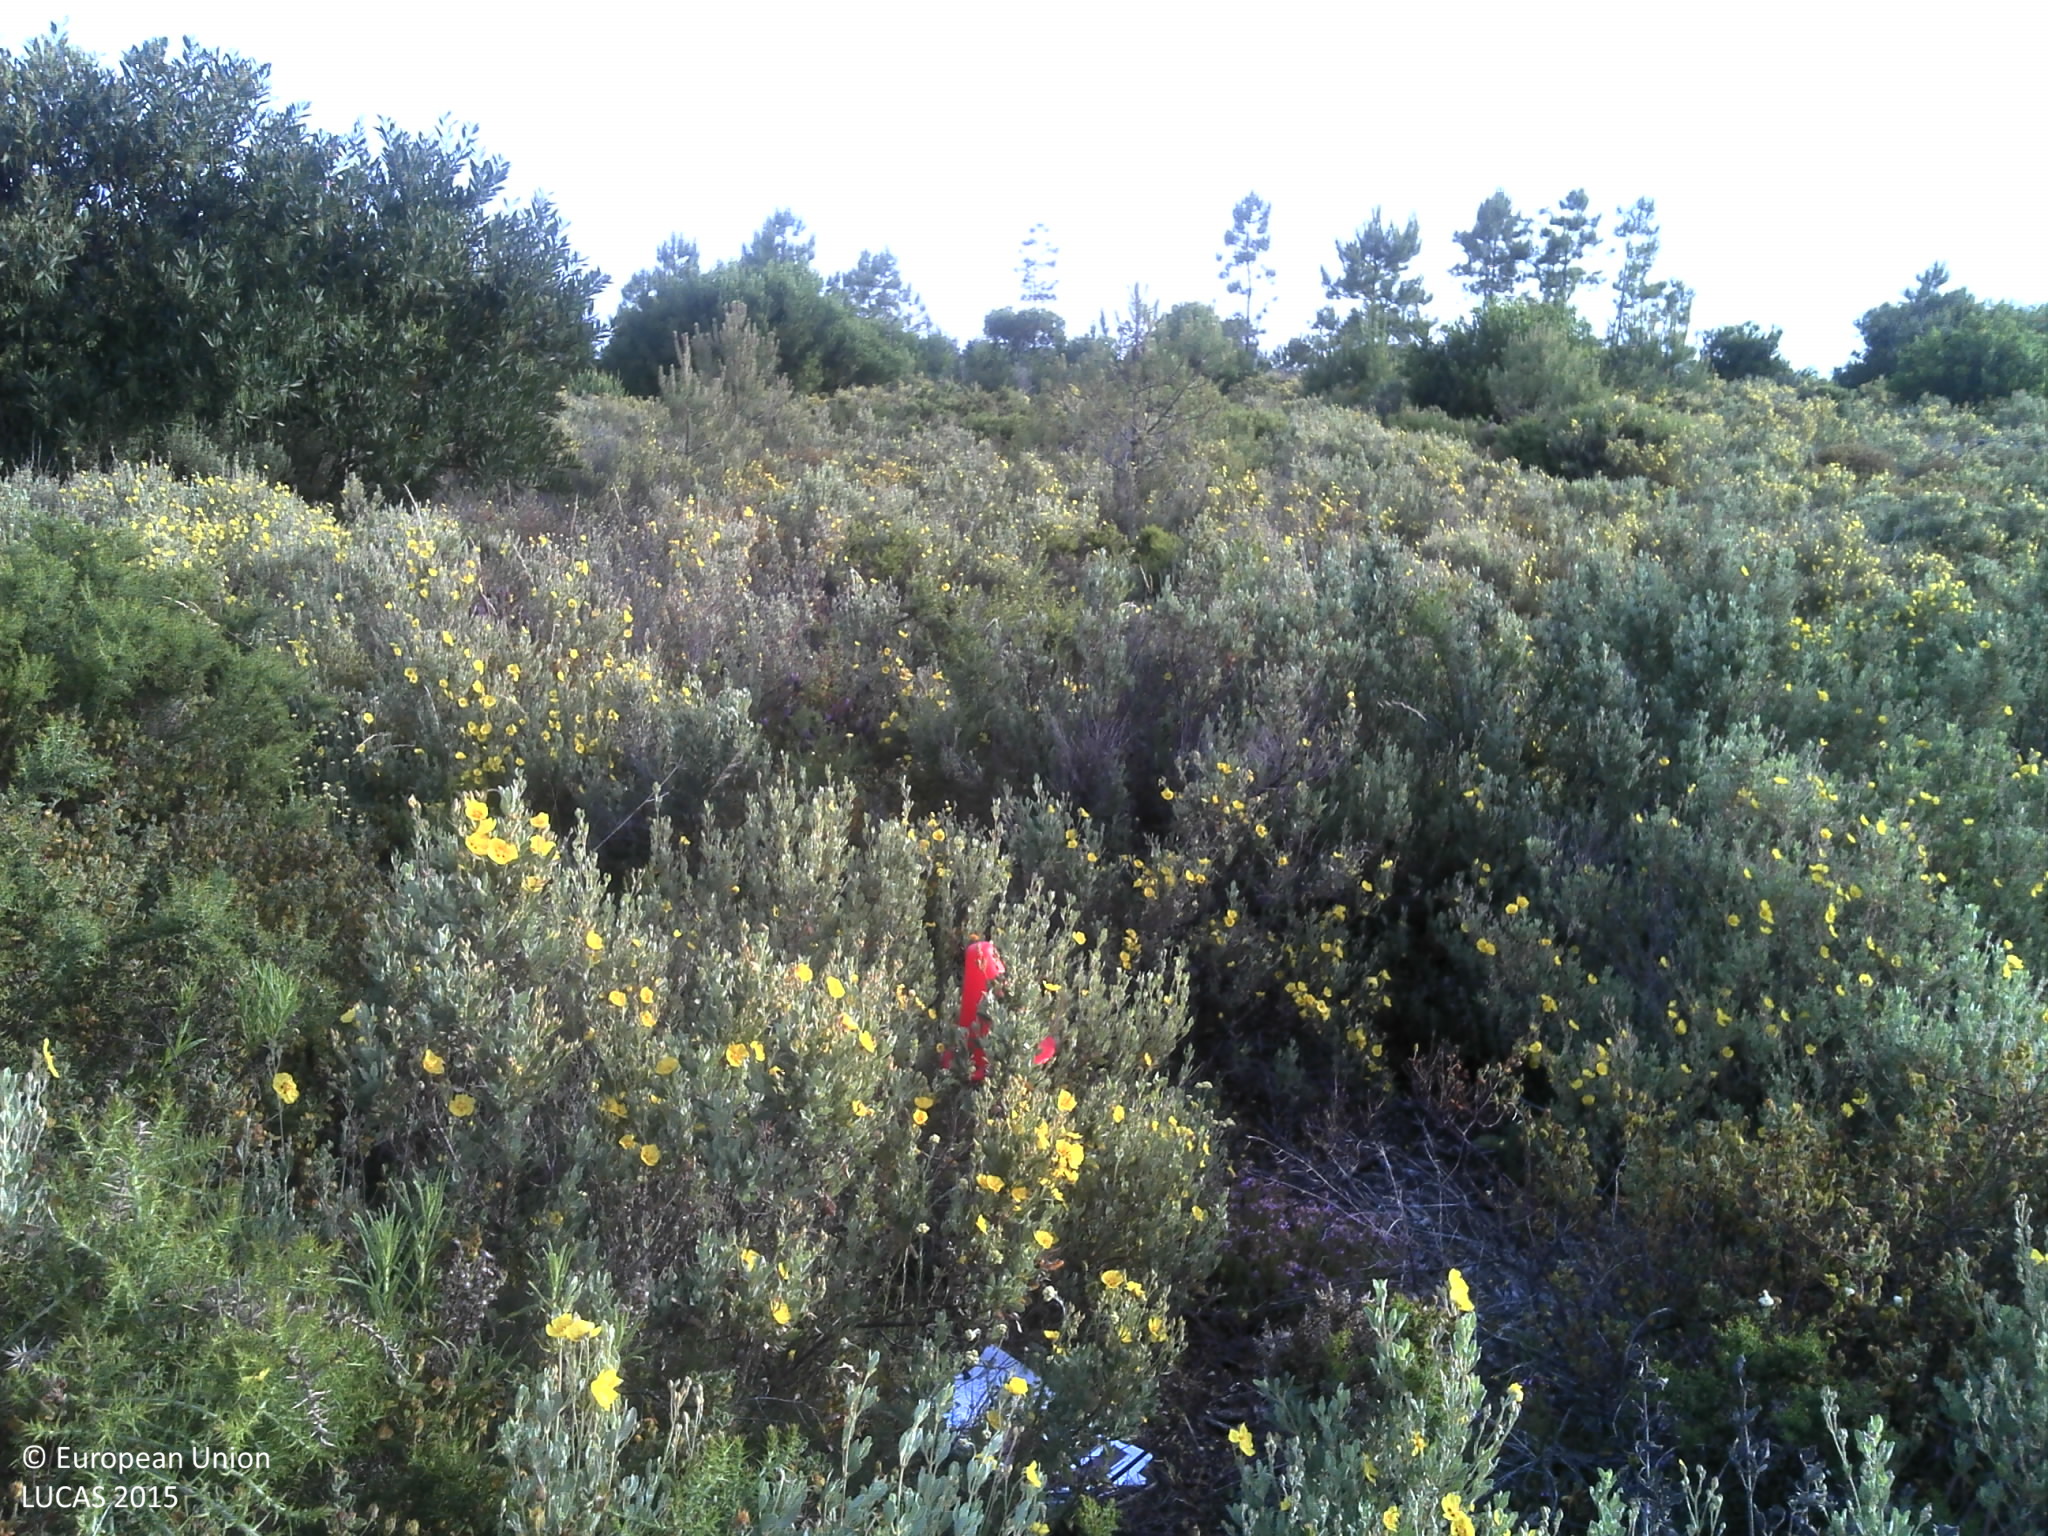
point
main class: Shrubland
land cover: Shrubland with sparse tree cover
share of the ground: 50 - 75 %
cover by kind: shrubs 60 %, herbaceous plants 25 %, consolidated bare surface 10 %, coniferous forest trees 5 %
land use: Semi-natural and natural areas not in use
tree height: < 5 m
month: May
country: PT
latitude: 37.6351
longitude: -8.7974
